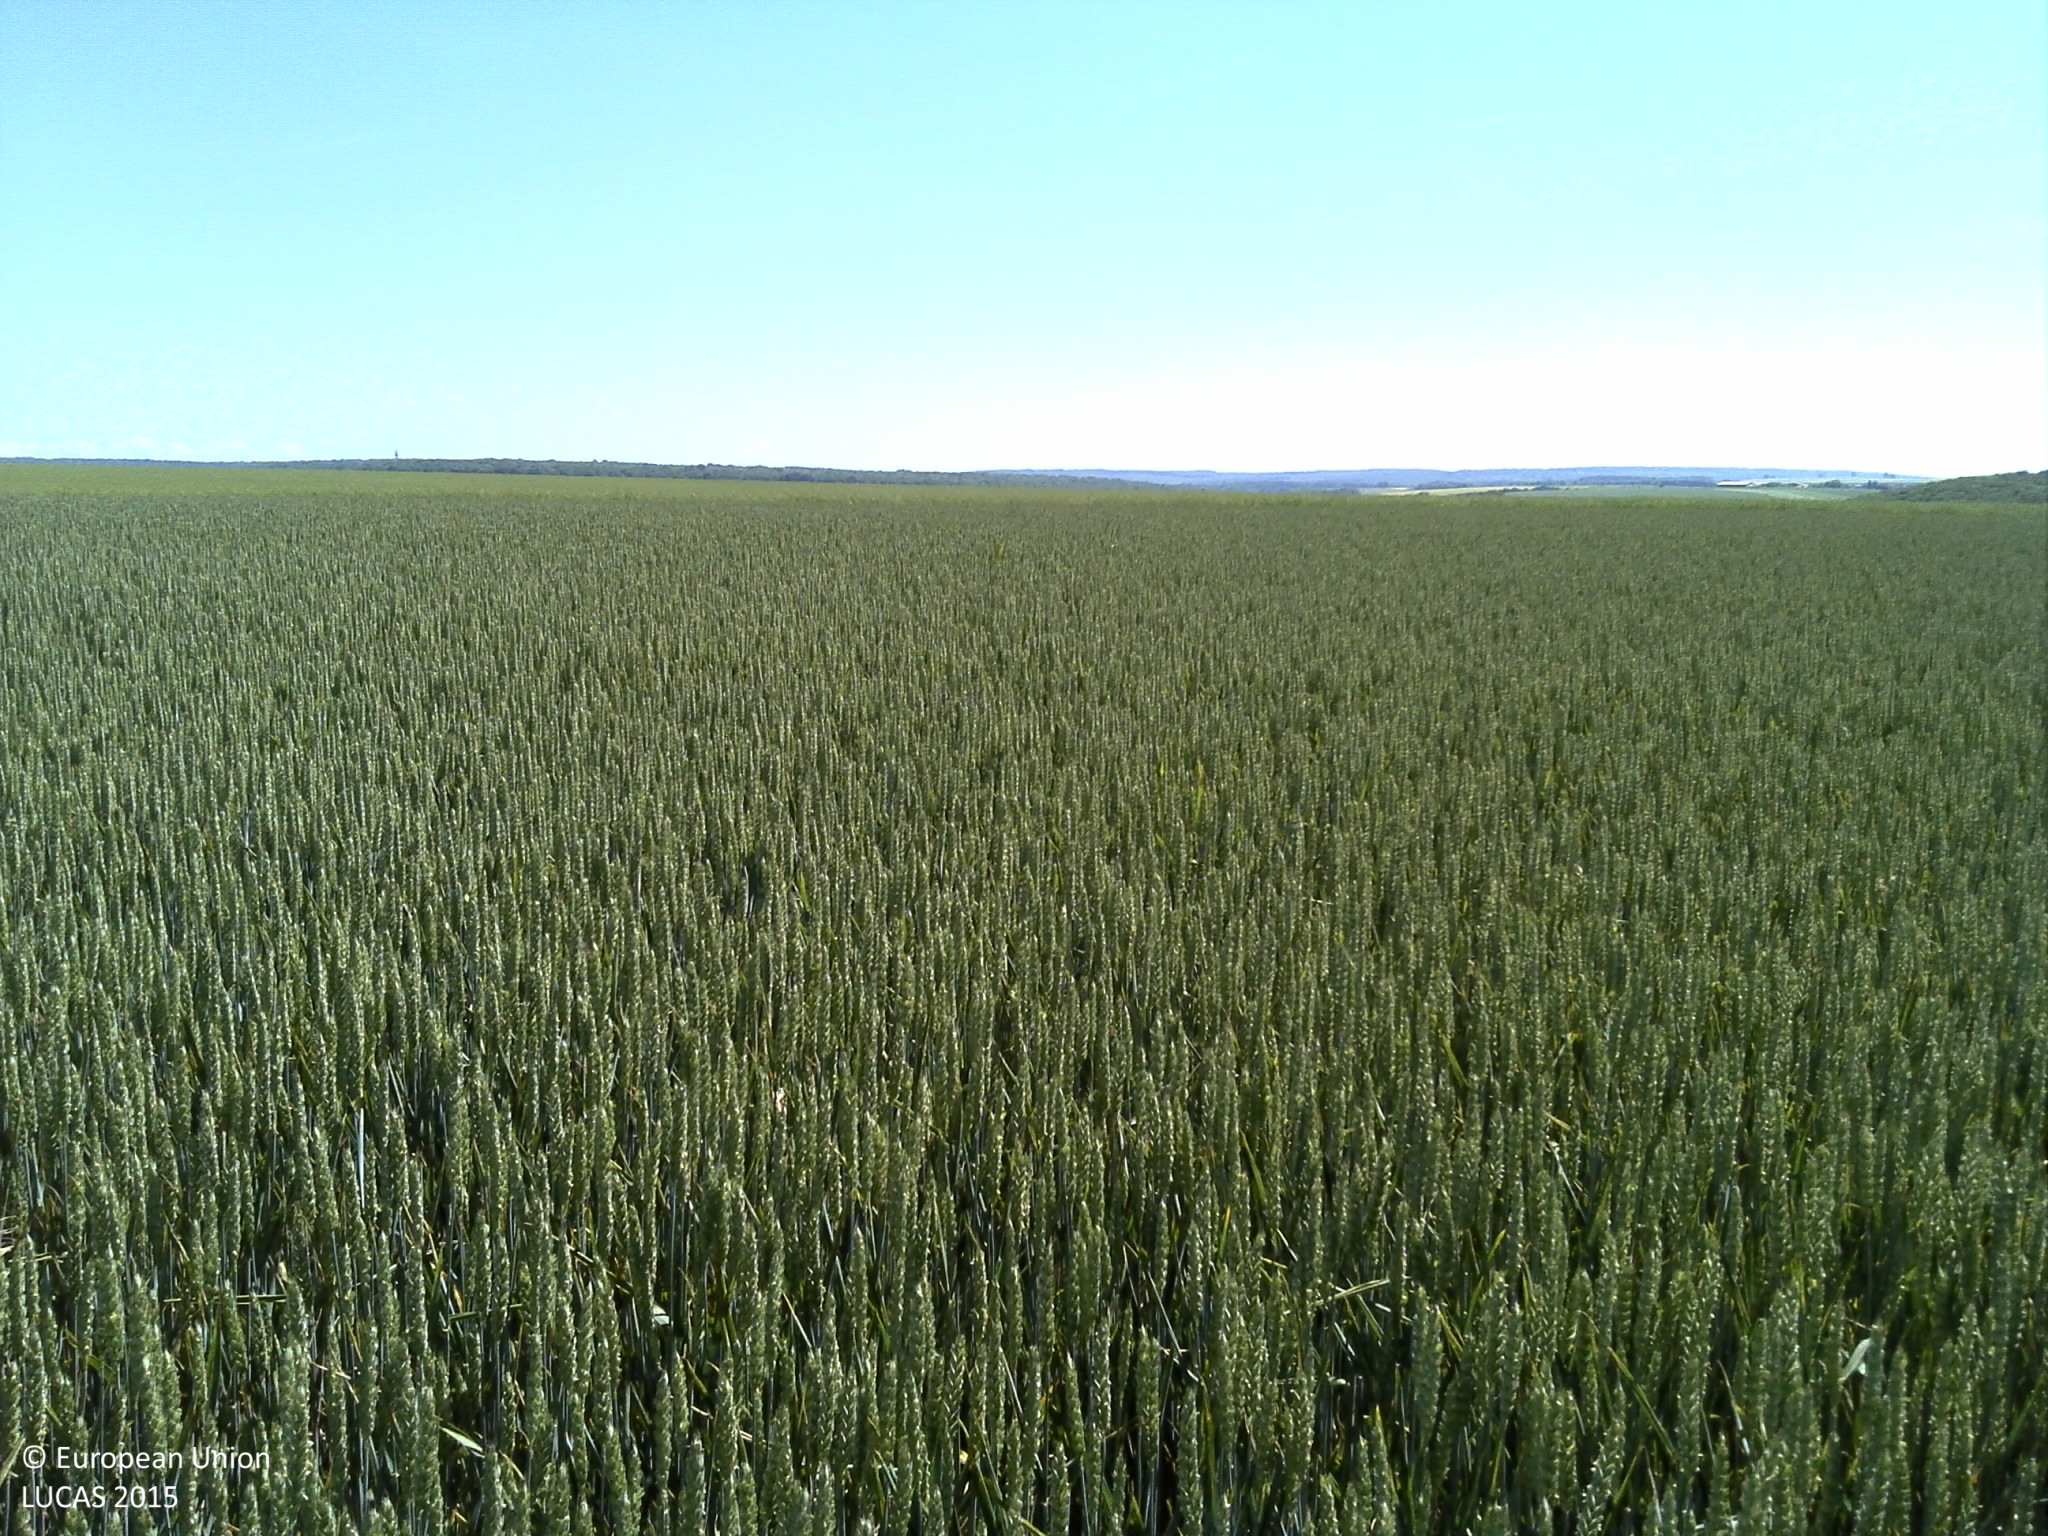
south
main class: Cropland
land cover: Common wheat
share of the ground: > 75 %
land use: Agriculture (excluding fallow land and kitchen gardens)
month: June
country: FR
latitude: 49.1241
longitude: 6.0119
